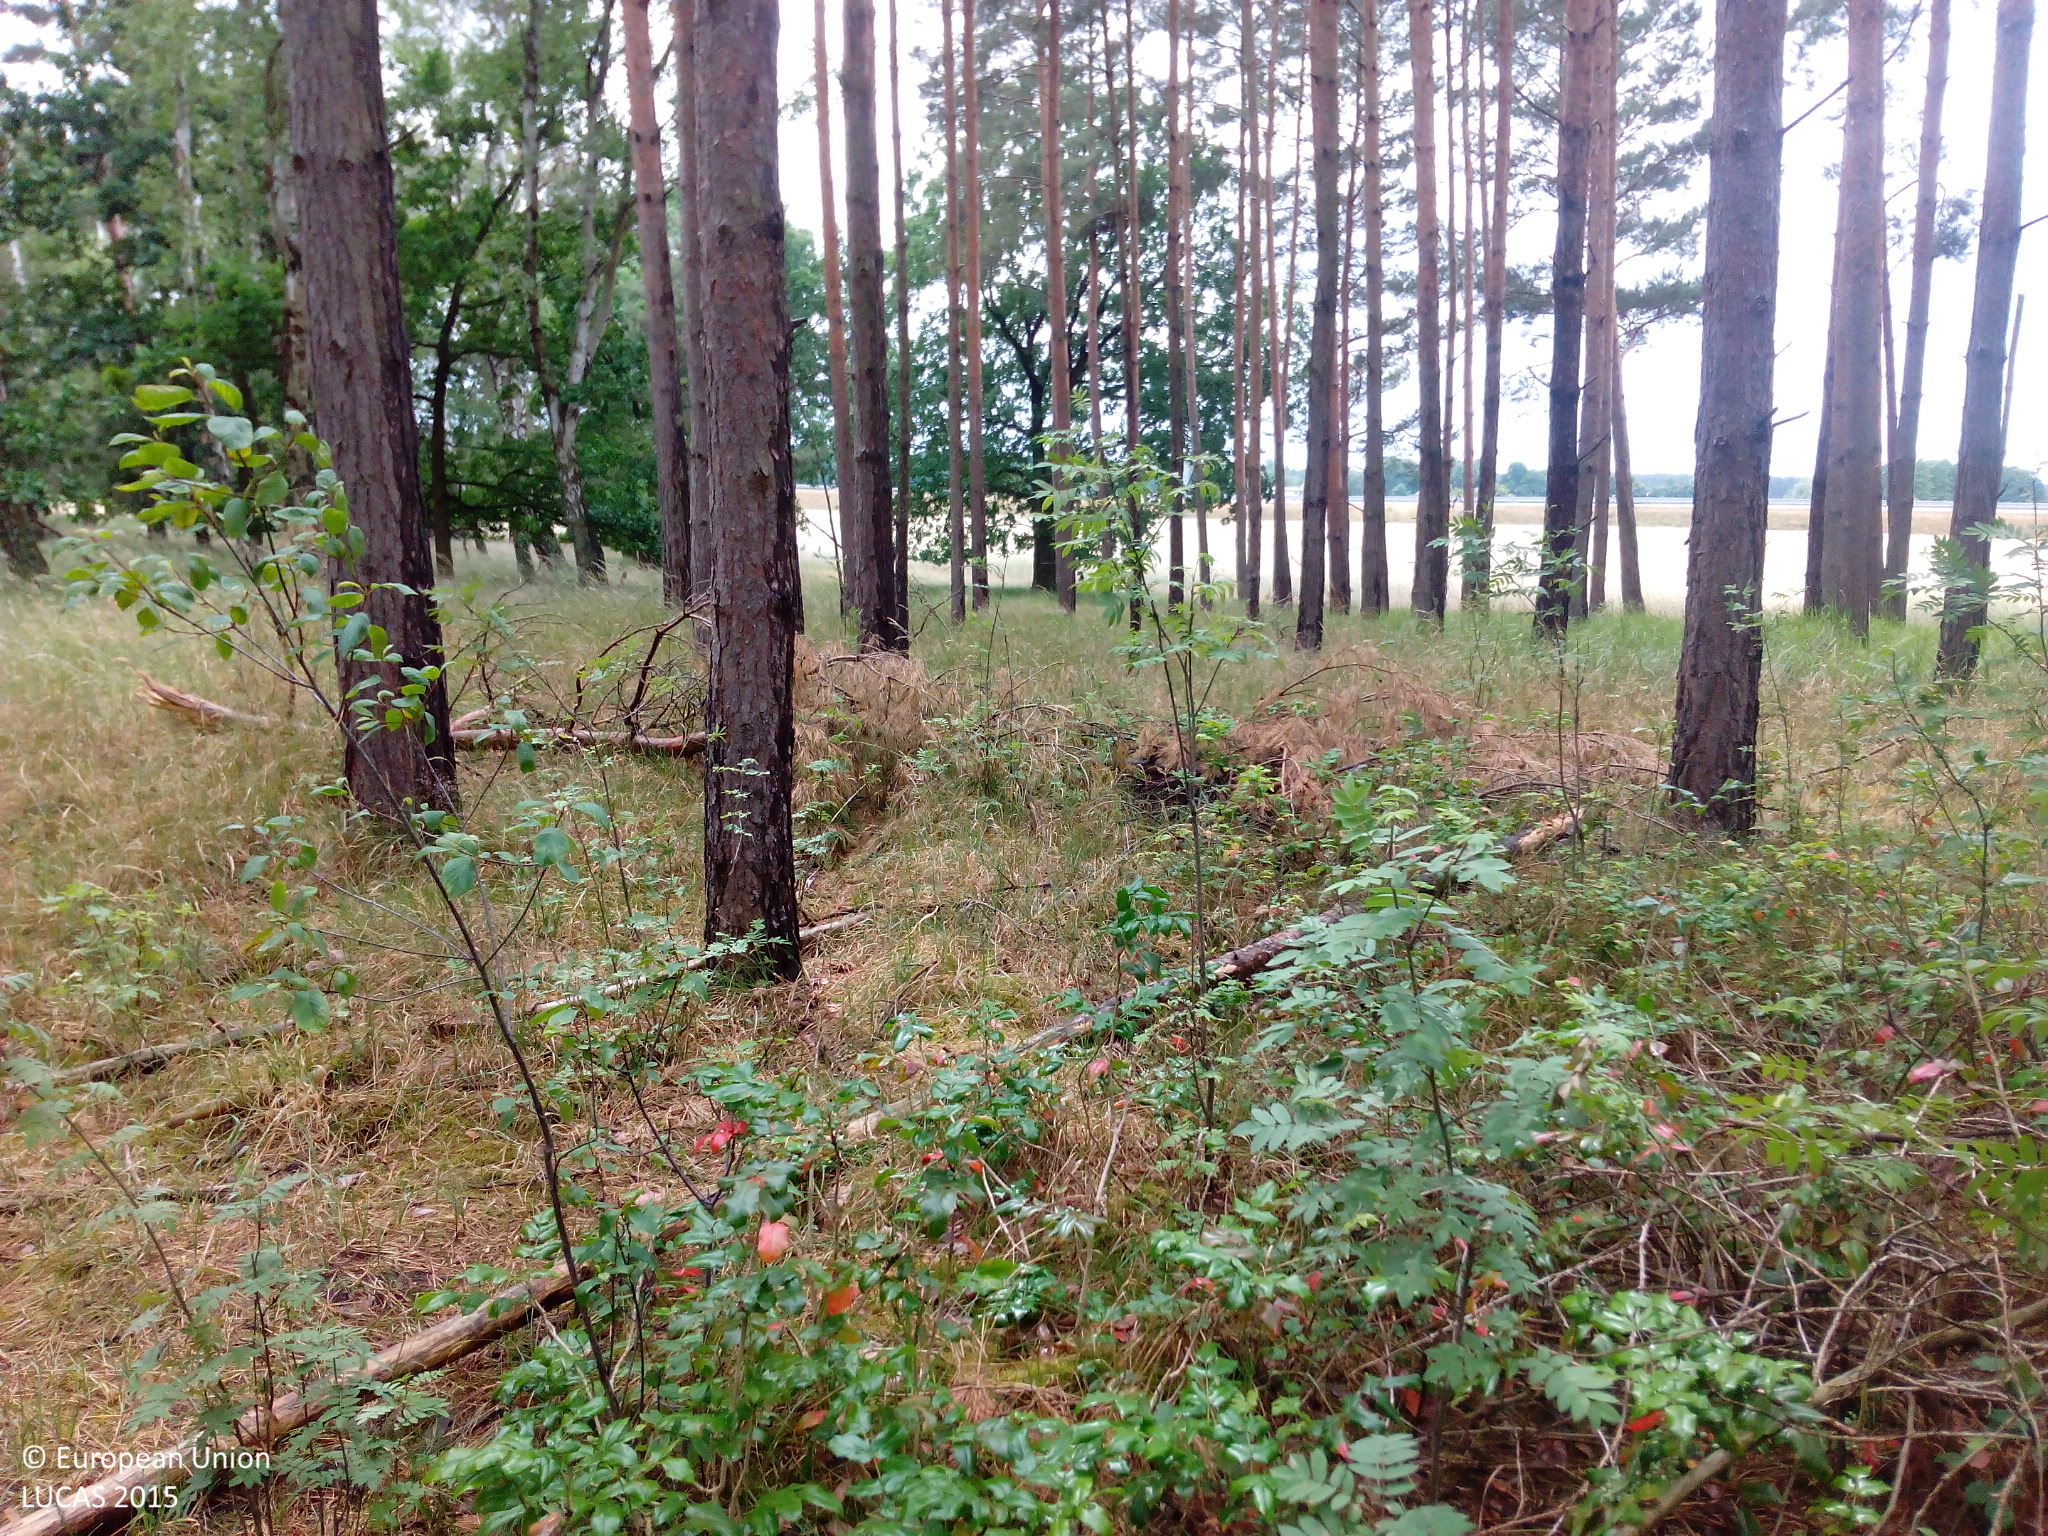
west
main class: Woodland
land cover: Pine dominated coniferous woodland
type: hemiboreal forest and nemoral coniferous forest and mixed broadleaved-coniferous forest
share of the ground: 50 - 75 %
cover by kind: coniferous forest trees 65 %, herbaceous plants 15 %, broadleaved forest trees 10 %, lichens and mosses 10 %
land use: Forestry
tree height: > 5 m
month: June
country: DE
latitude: 52.4084
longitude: 12.3369
